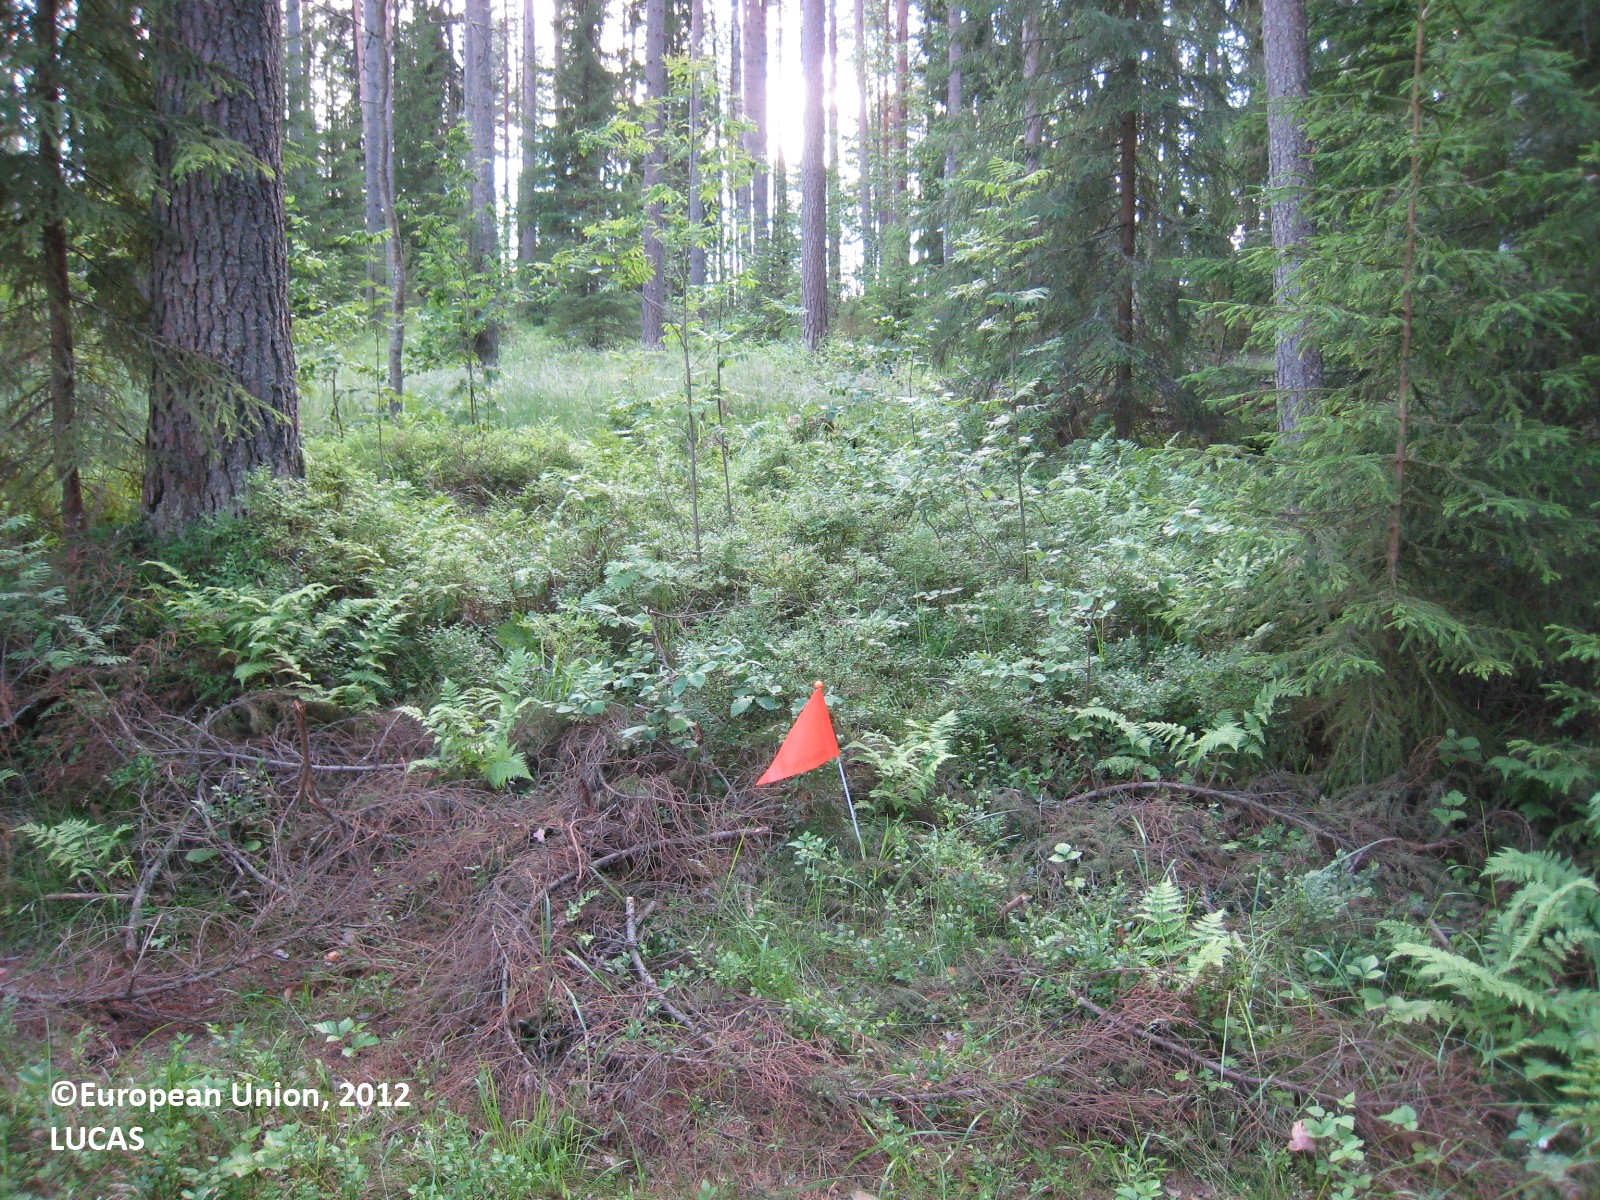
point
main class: Woodland
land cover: Other coniferous woodland
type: boreal forest
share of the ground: 50 - 75 %
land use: Forestry
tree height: > 5 m
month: July
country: FI
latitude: 63.0665
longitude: 25.7653
